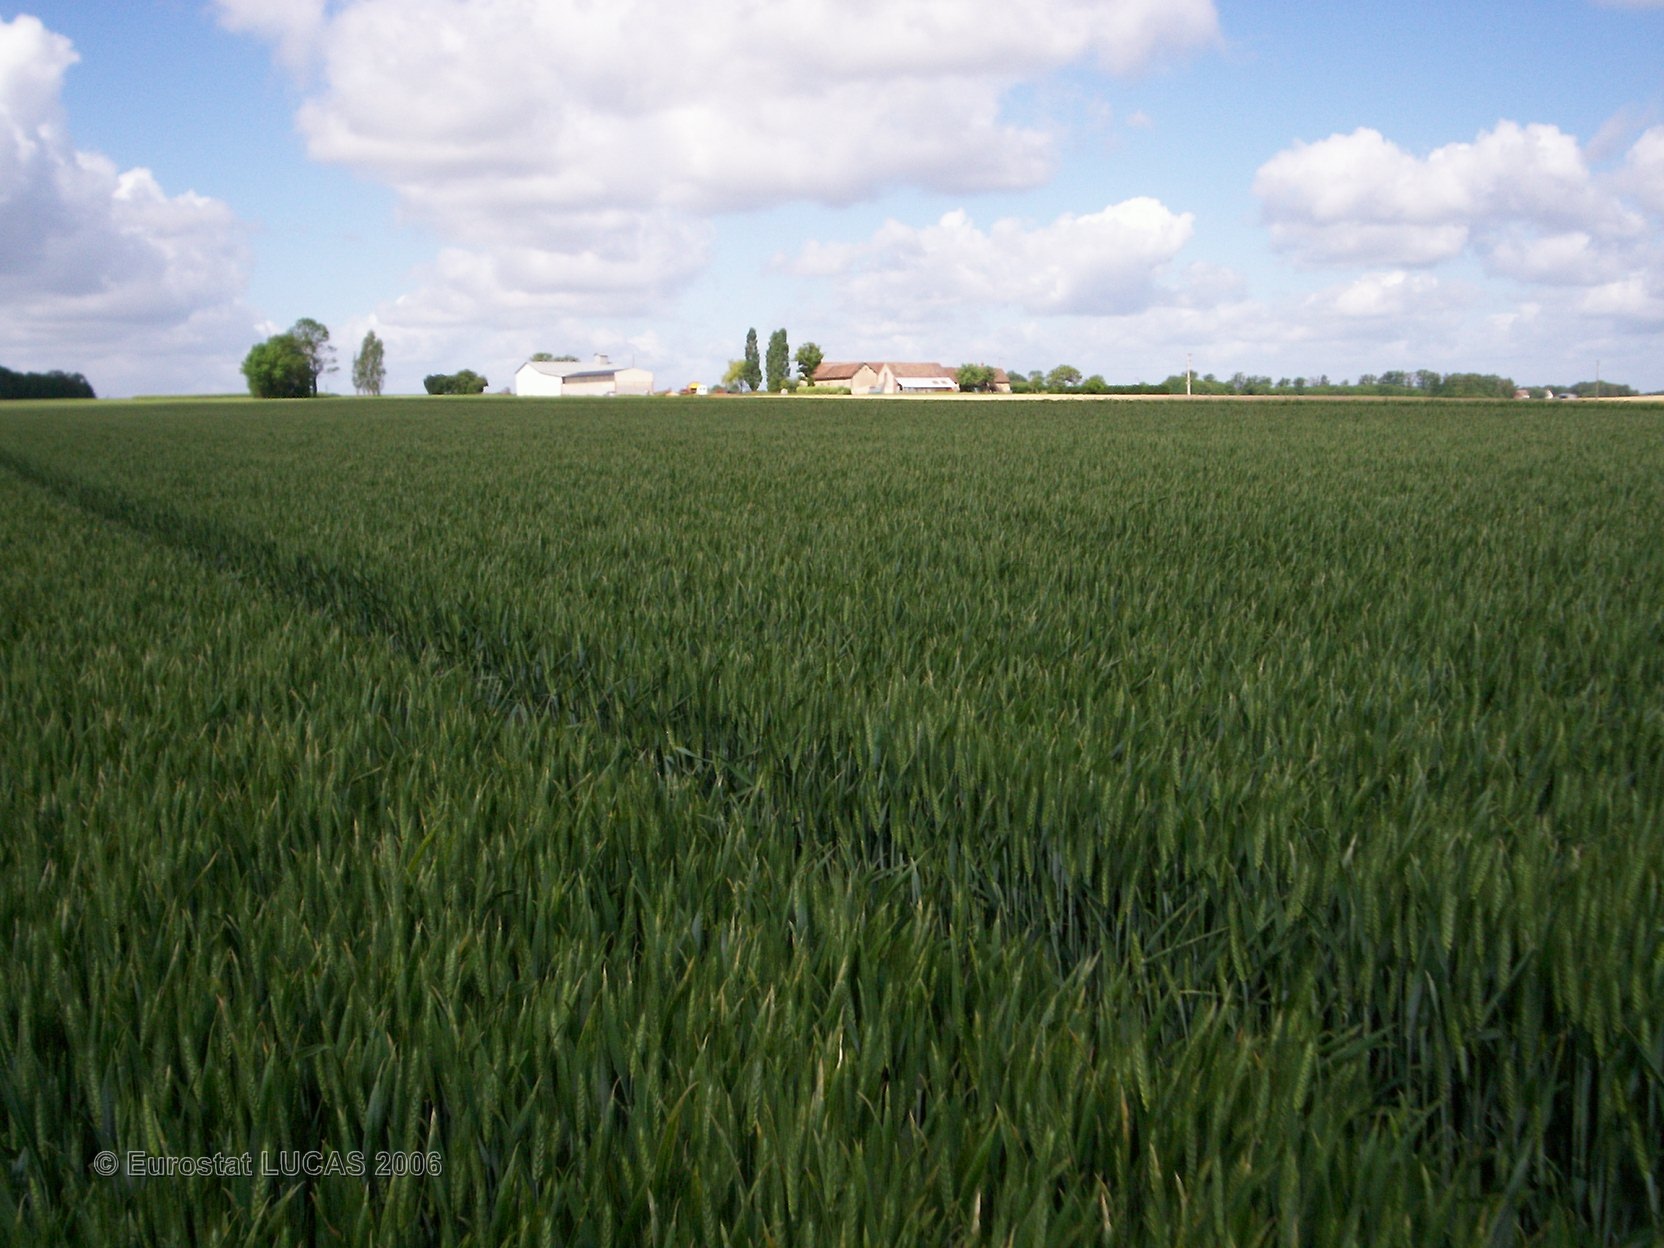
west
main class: Cropland
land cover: Common wheat
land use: Agriculture (excluding fallow land and kitchen gardens)
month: May
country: FR
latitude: 47.5884
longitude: 0.8457
